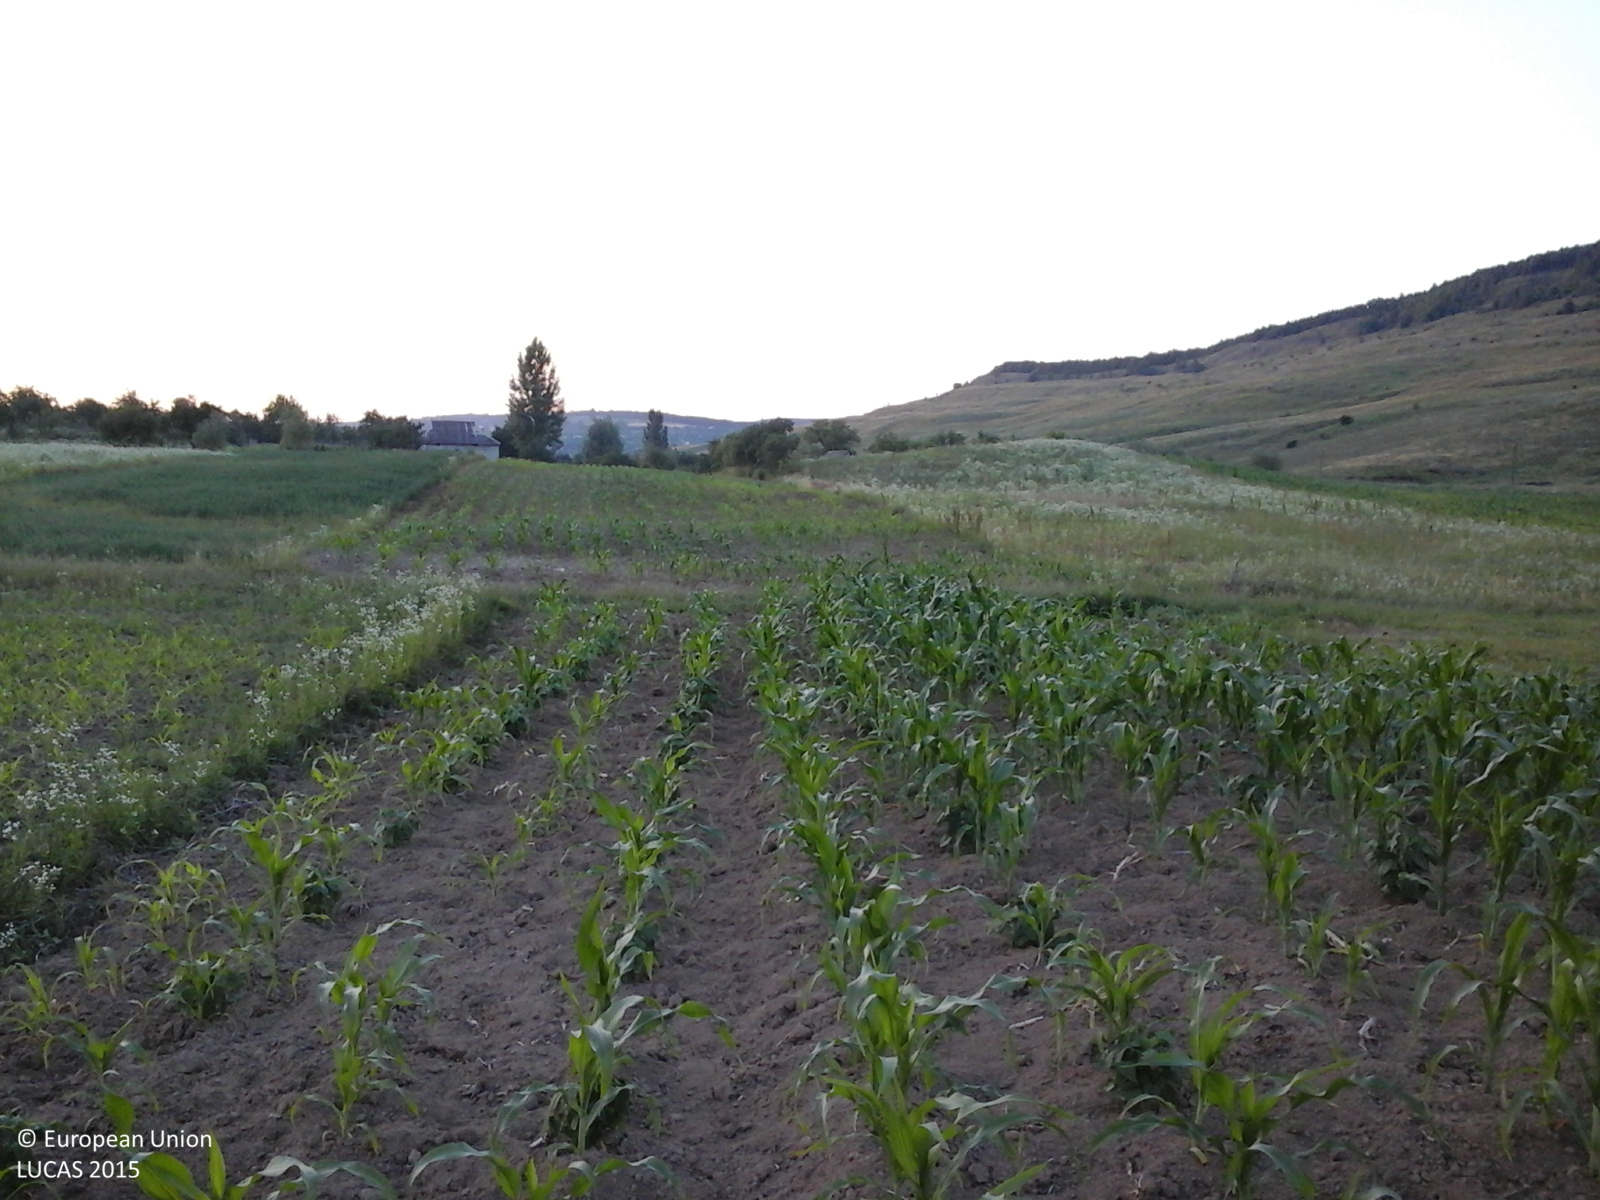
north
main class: Cropland
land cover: Maize
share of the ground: 25 - 50 %
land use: Agriculture (excluding fallow land and kitchen gardens)
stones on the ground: < 10 %
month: June
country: RO
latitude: 47.6033
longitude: 26.7908
